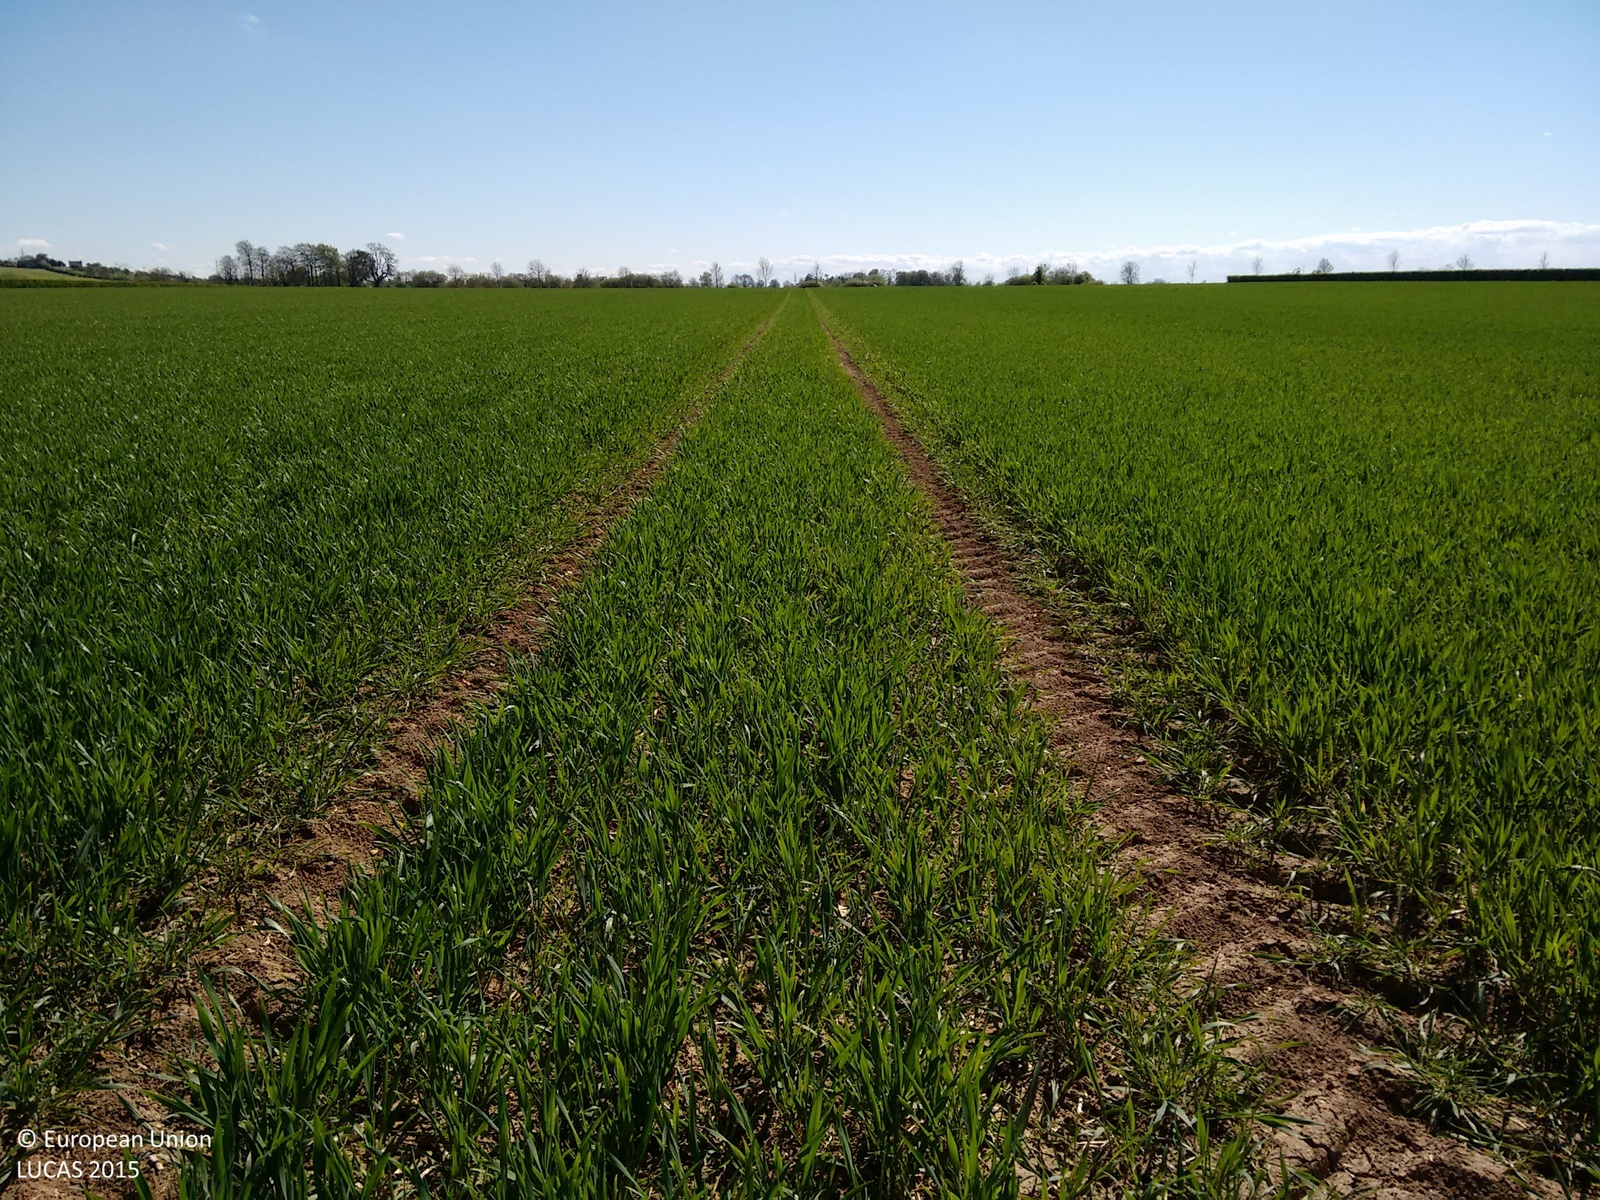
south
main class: Cropland
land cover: Barley
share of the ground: > 75 %
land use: Agriculture (excluding fallow land and kitchen gardens)
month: April
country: GB
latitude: 53.2993
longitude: -0.5867
